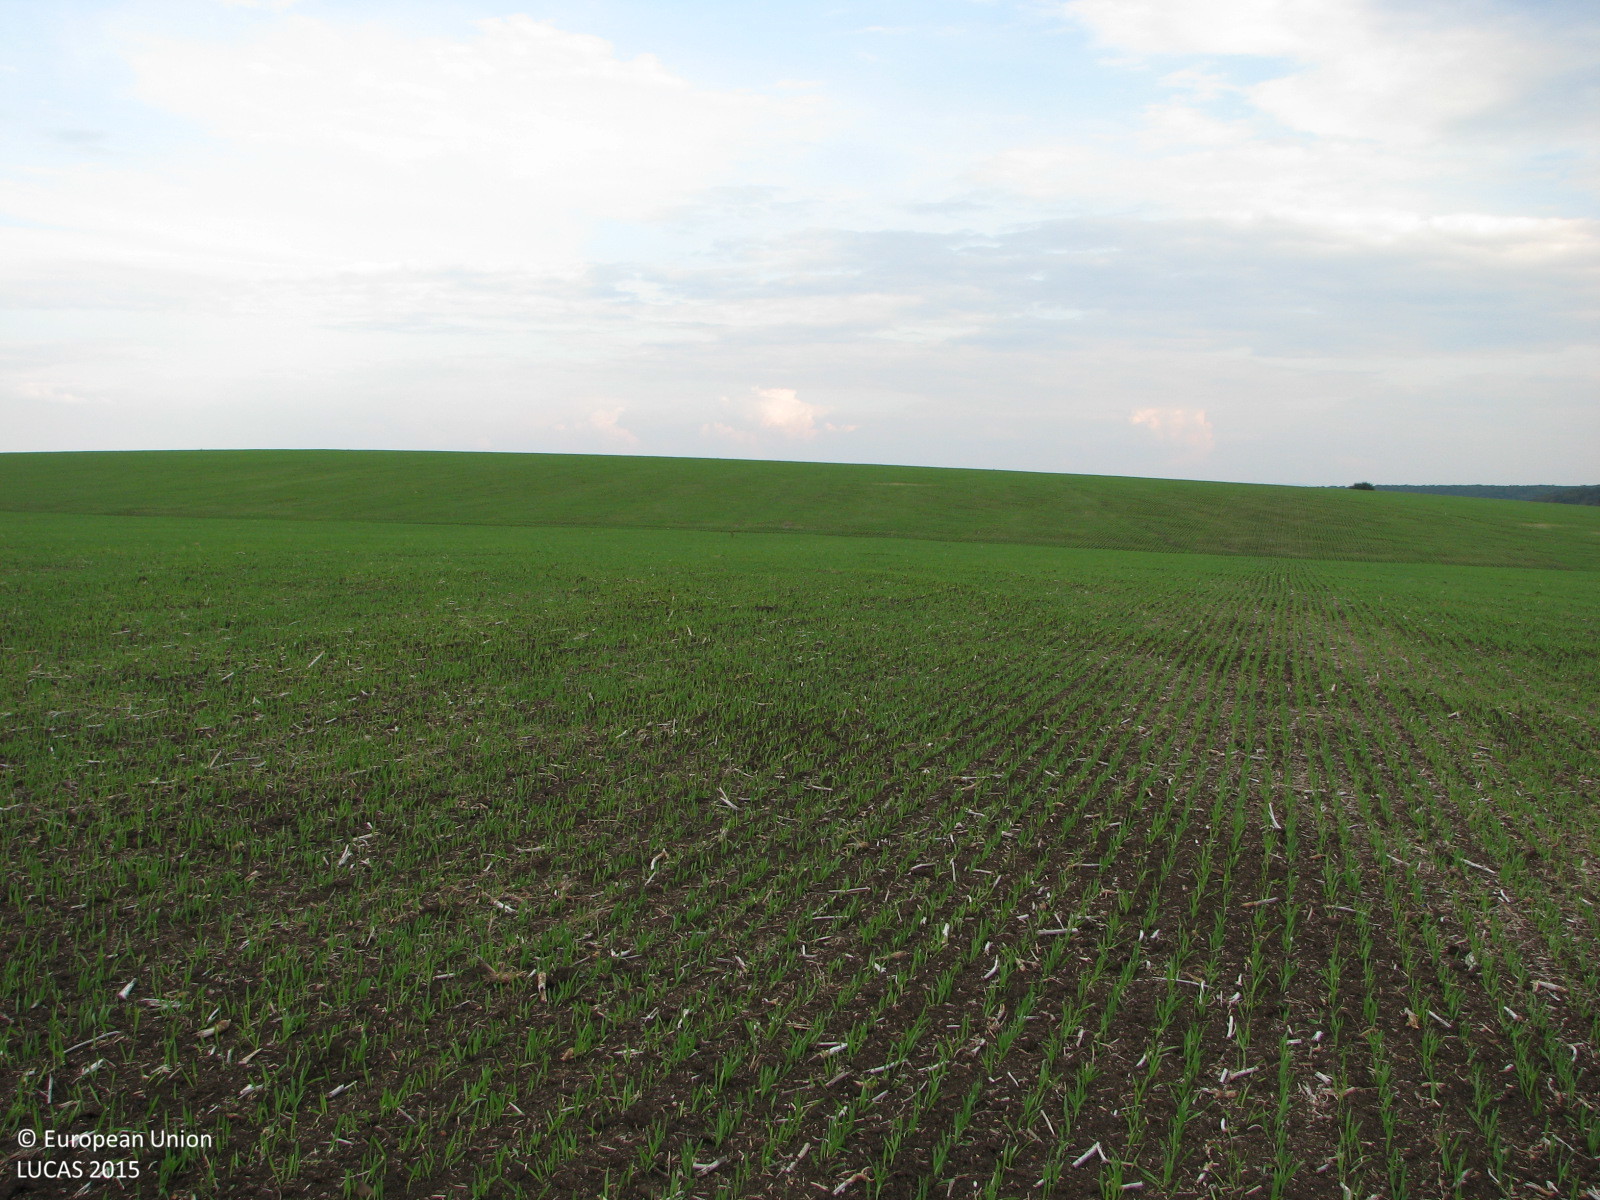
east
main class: Cropland
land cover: Common wheat
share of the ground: 10 - 25 %
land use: Agriculture (excluding fallow land and kitchen gardens)
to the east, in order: Common wheat
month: October
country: BG
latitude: 42.2876
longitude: 26.4732
